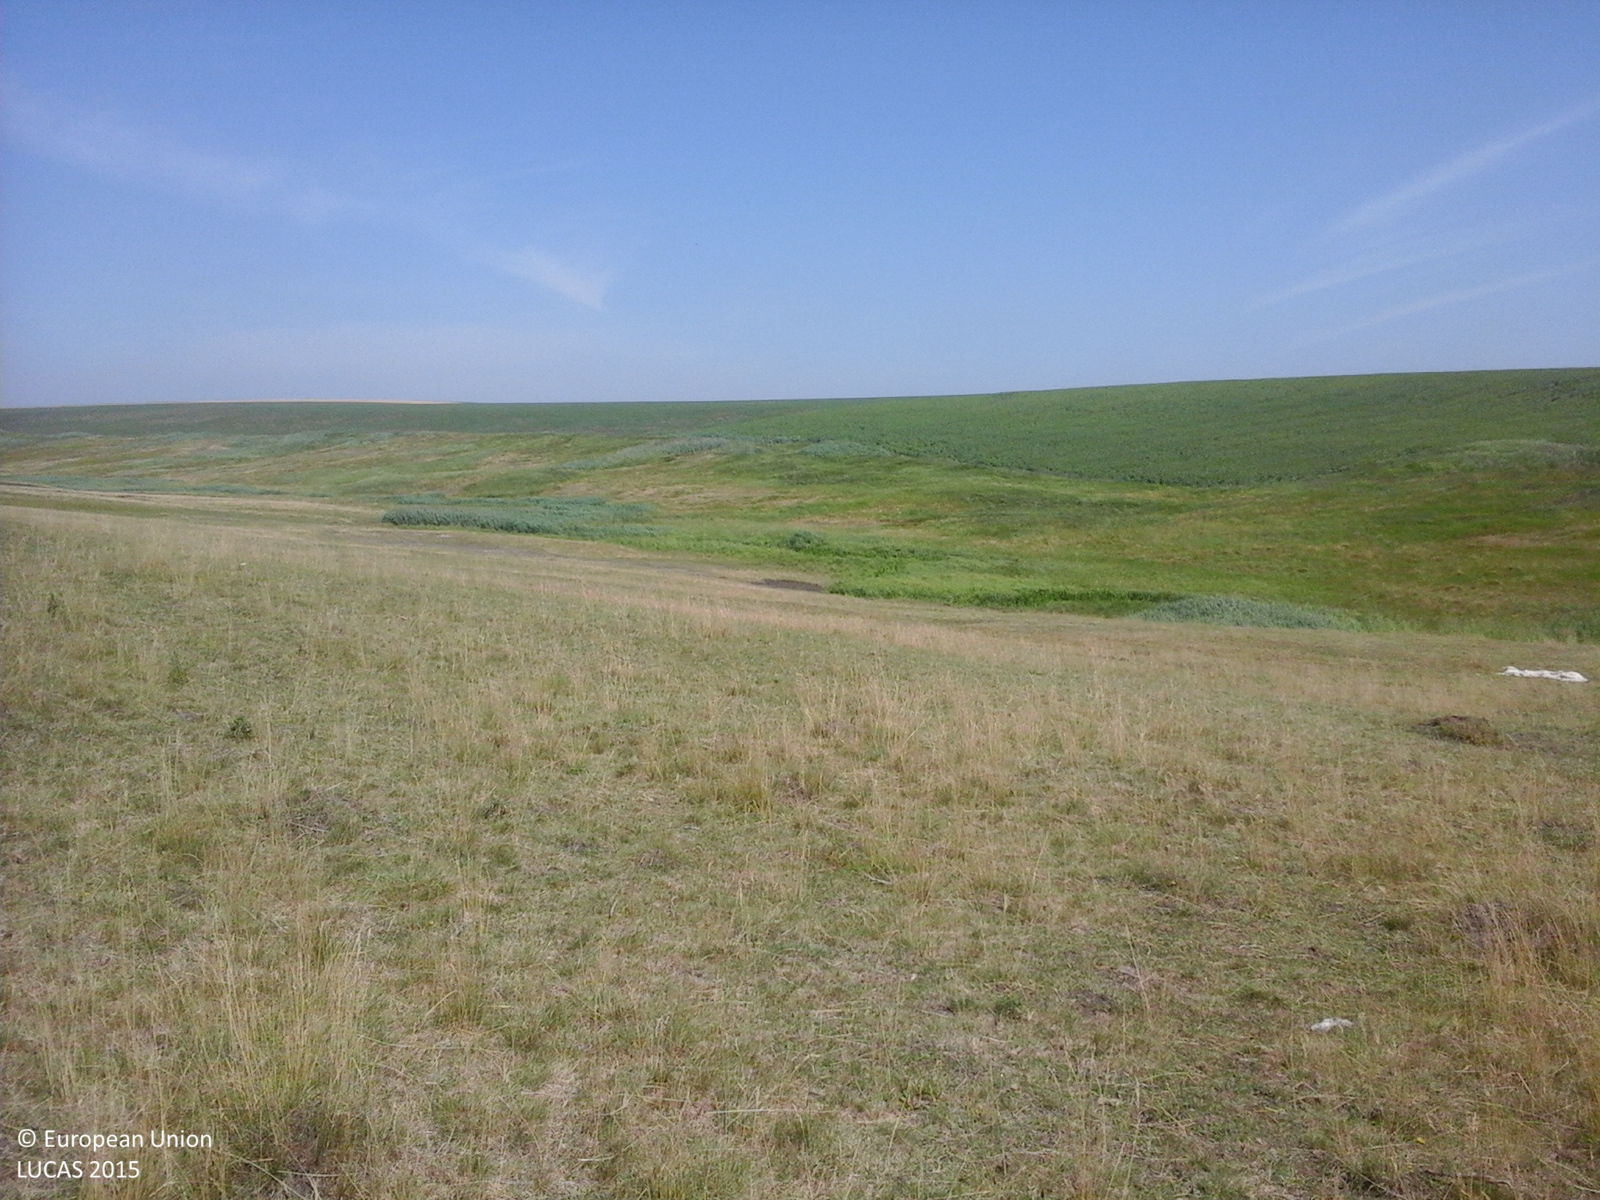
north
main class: Grassland
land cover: Grassland without tree/shrub cover
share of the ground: > 75 %
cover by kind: herbaceous plants 100 %
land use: Agriculture (excluding fallow land and kitchen gardens)
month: June
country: RO
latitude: 47.7153
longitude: 27.1304
